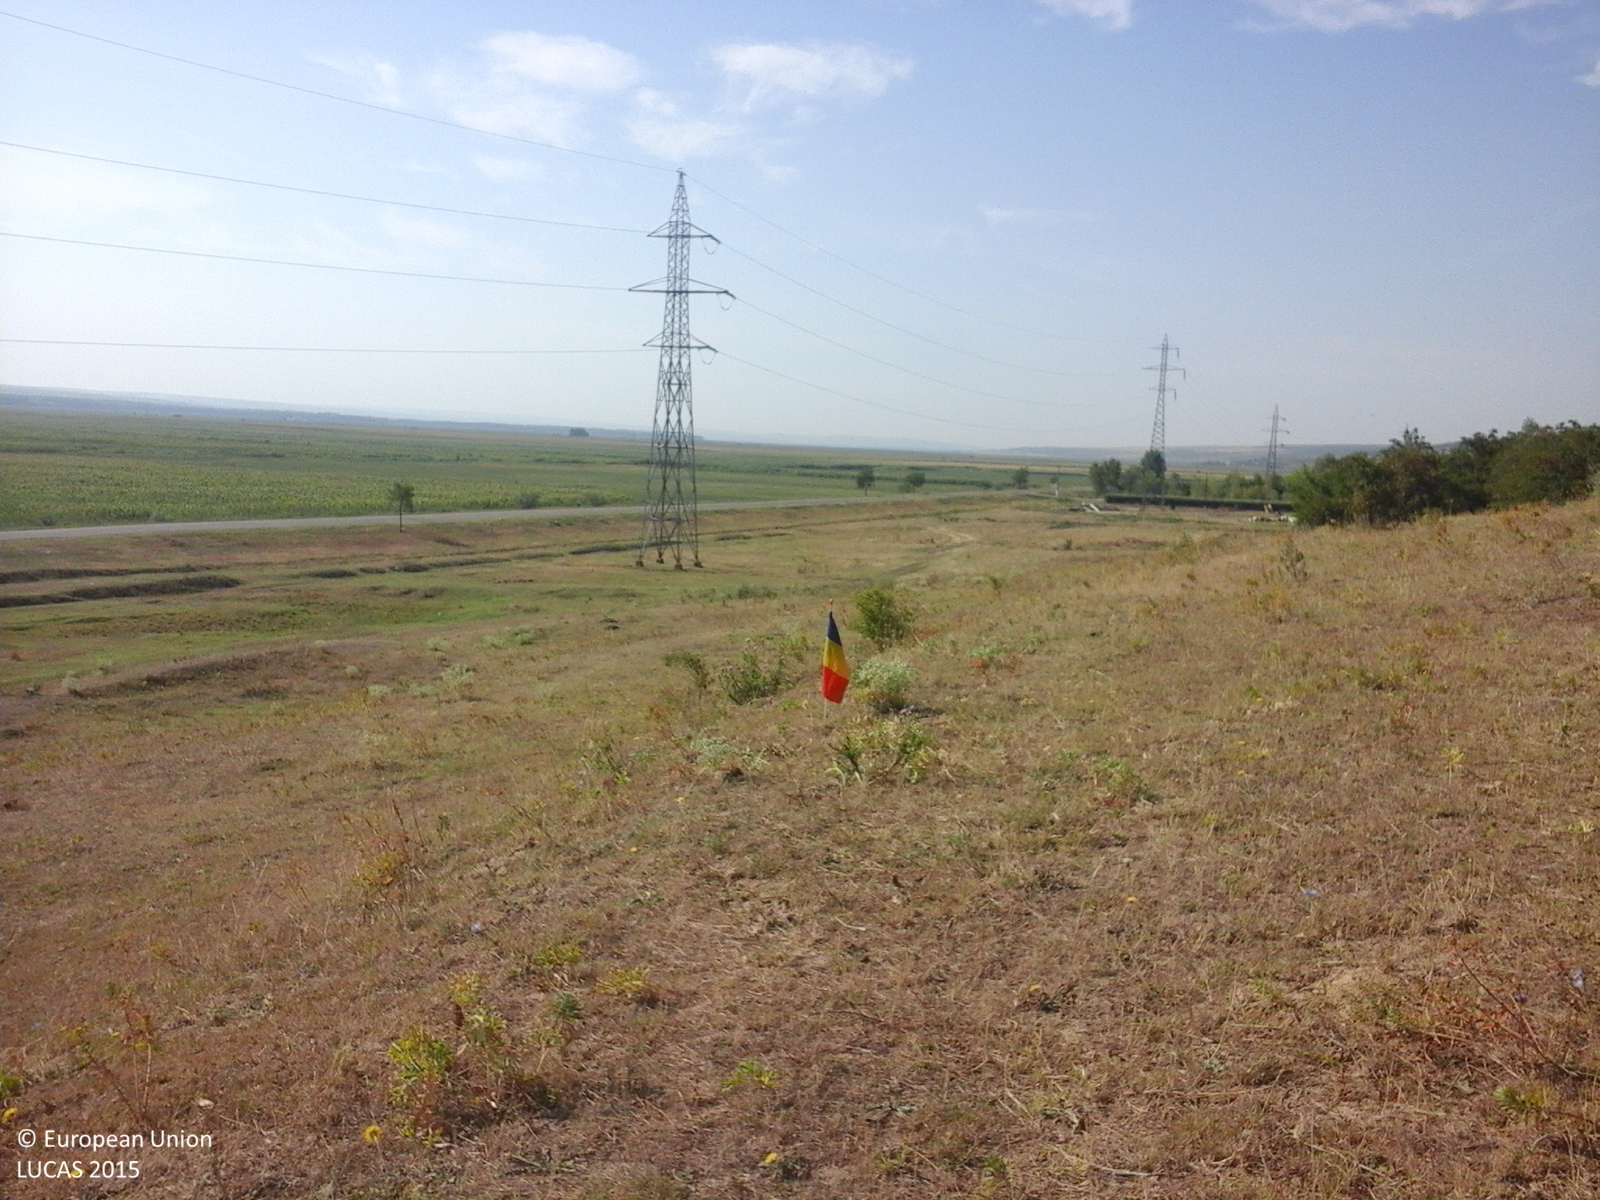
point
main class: Grassland
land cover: Grassland with sparse tree/shrub cover
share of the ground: > 75 %
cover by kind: herbaceous plants 85 %, shrubs 10 %, broadleaved forest trees 5 %
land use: Agriculture (excluding fallow land and kitchen gardens)
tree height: < 5 m
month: July
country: RO
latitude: 46.5661
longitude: 28.1754
